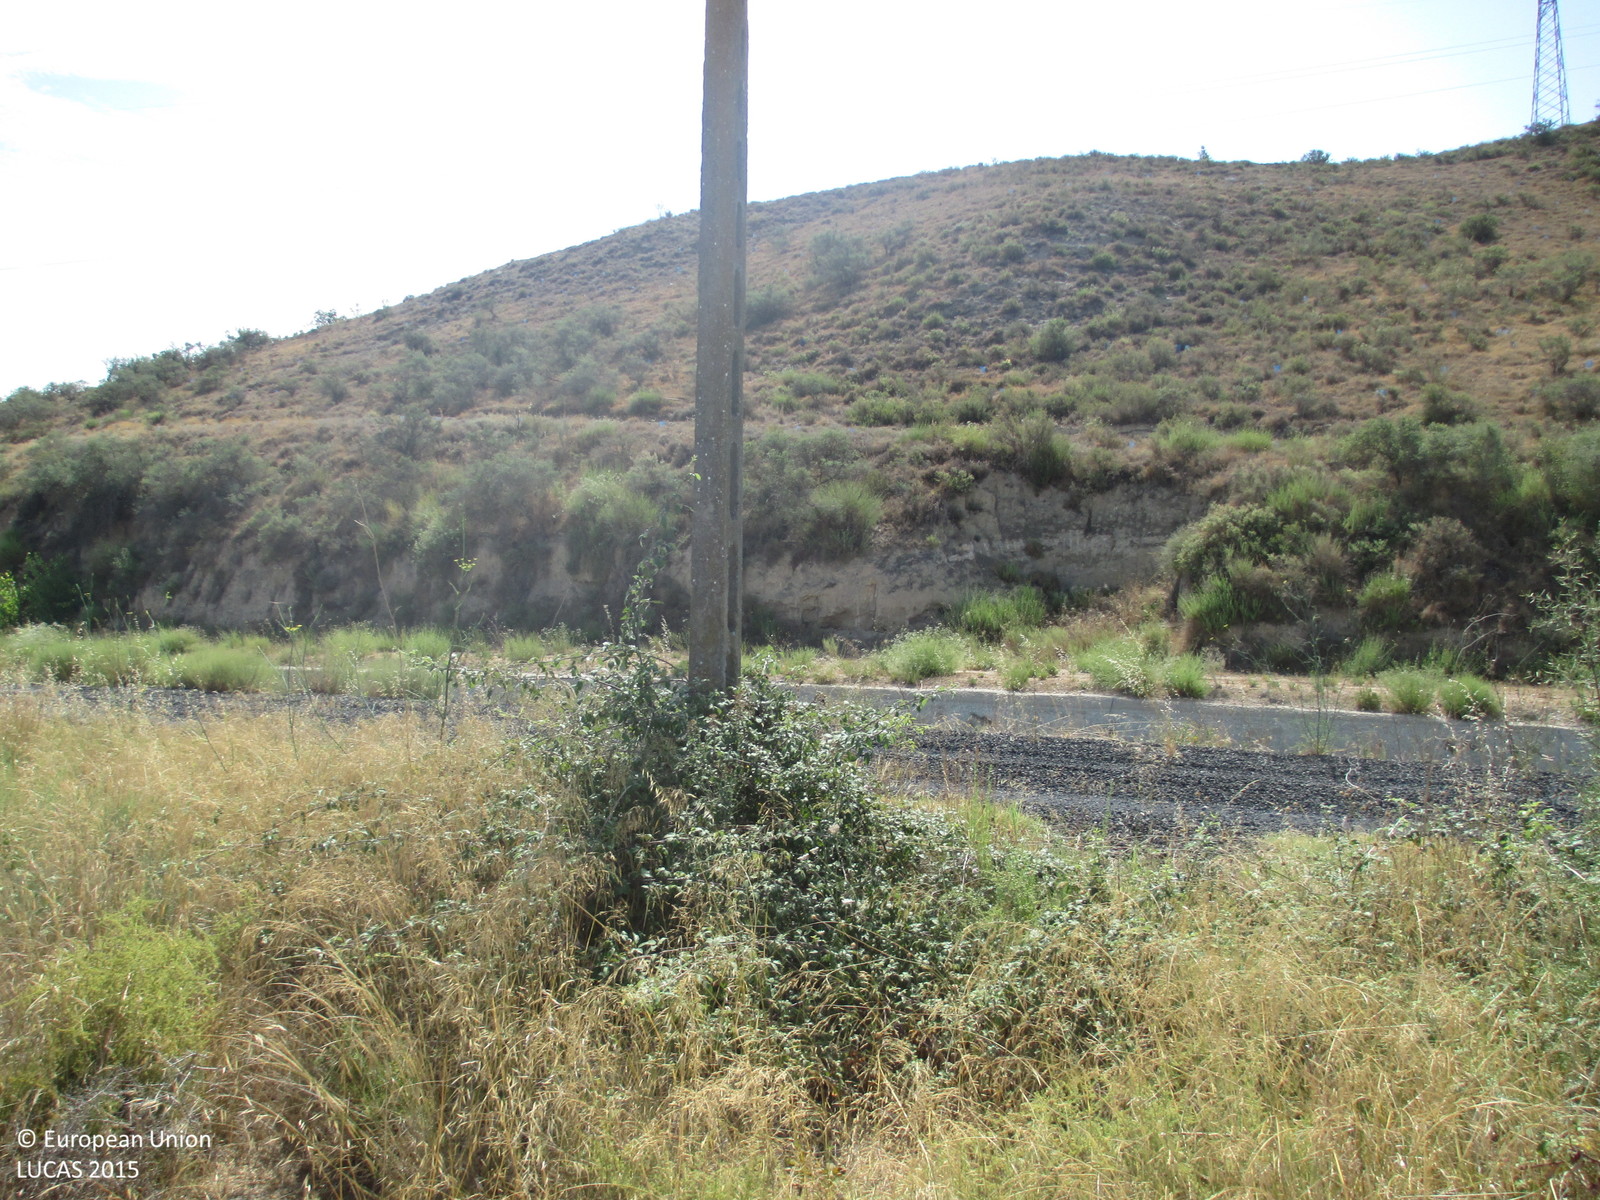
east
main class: Shrubland
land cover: Shrubland without tree cover
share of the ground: > 75 %
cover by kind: shrubs 95 %, herbaceous plants 5 %
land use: Semi-natural and natural areas not in use
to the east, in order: Shrubland without tree cover; Tracks; Inland fresh running water; Shrubland with sparse tree cover; Barley; Electric lines; Barley; Nuts trees; Electric lines; Nuts trees; Shruby margins; Barley
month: July
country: ES
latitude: 41.9772
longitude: 0.1951
